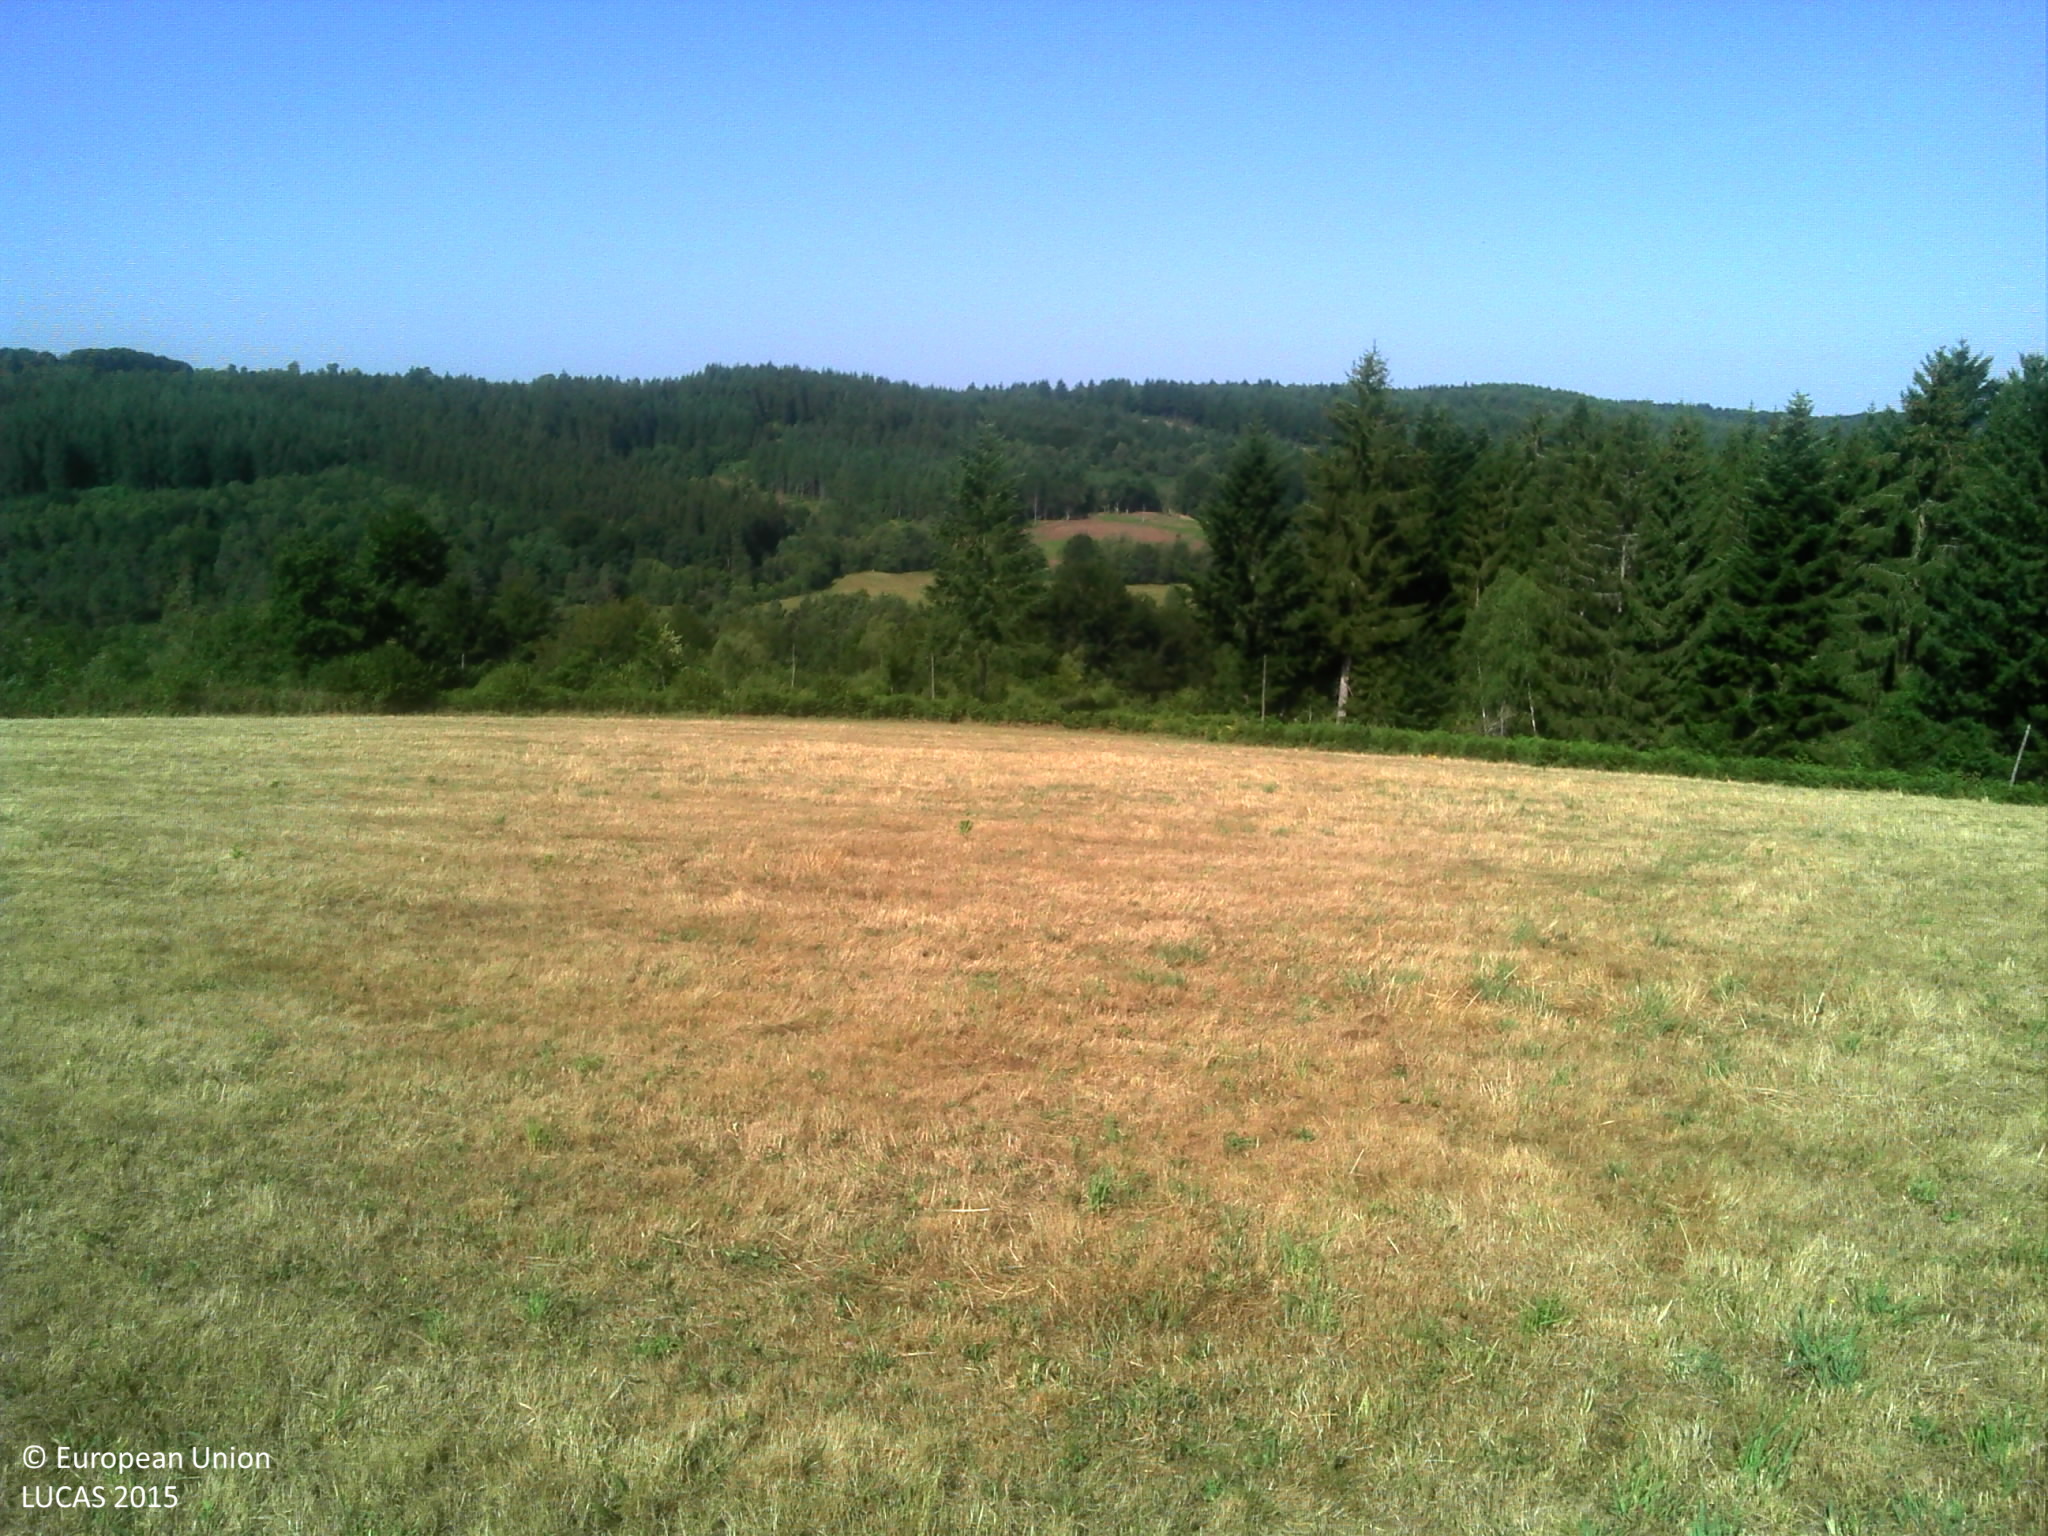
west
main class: Grassland
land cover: Grassland without tree/shrub cover
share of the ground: > 75 %
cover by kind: herbaceous plants 100 %
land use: Agriculture (excluding fallow land and kitchen gardens)
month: August
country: FR
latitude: 45.6777
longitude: 2.3328
